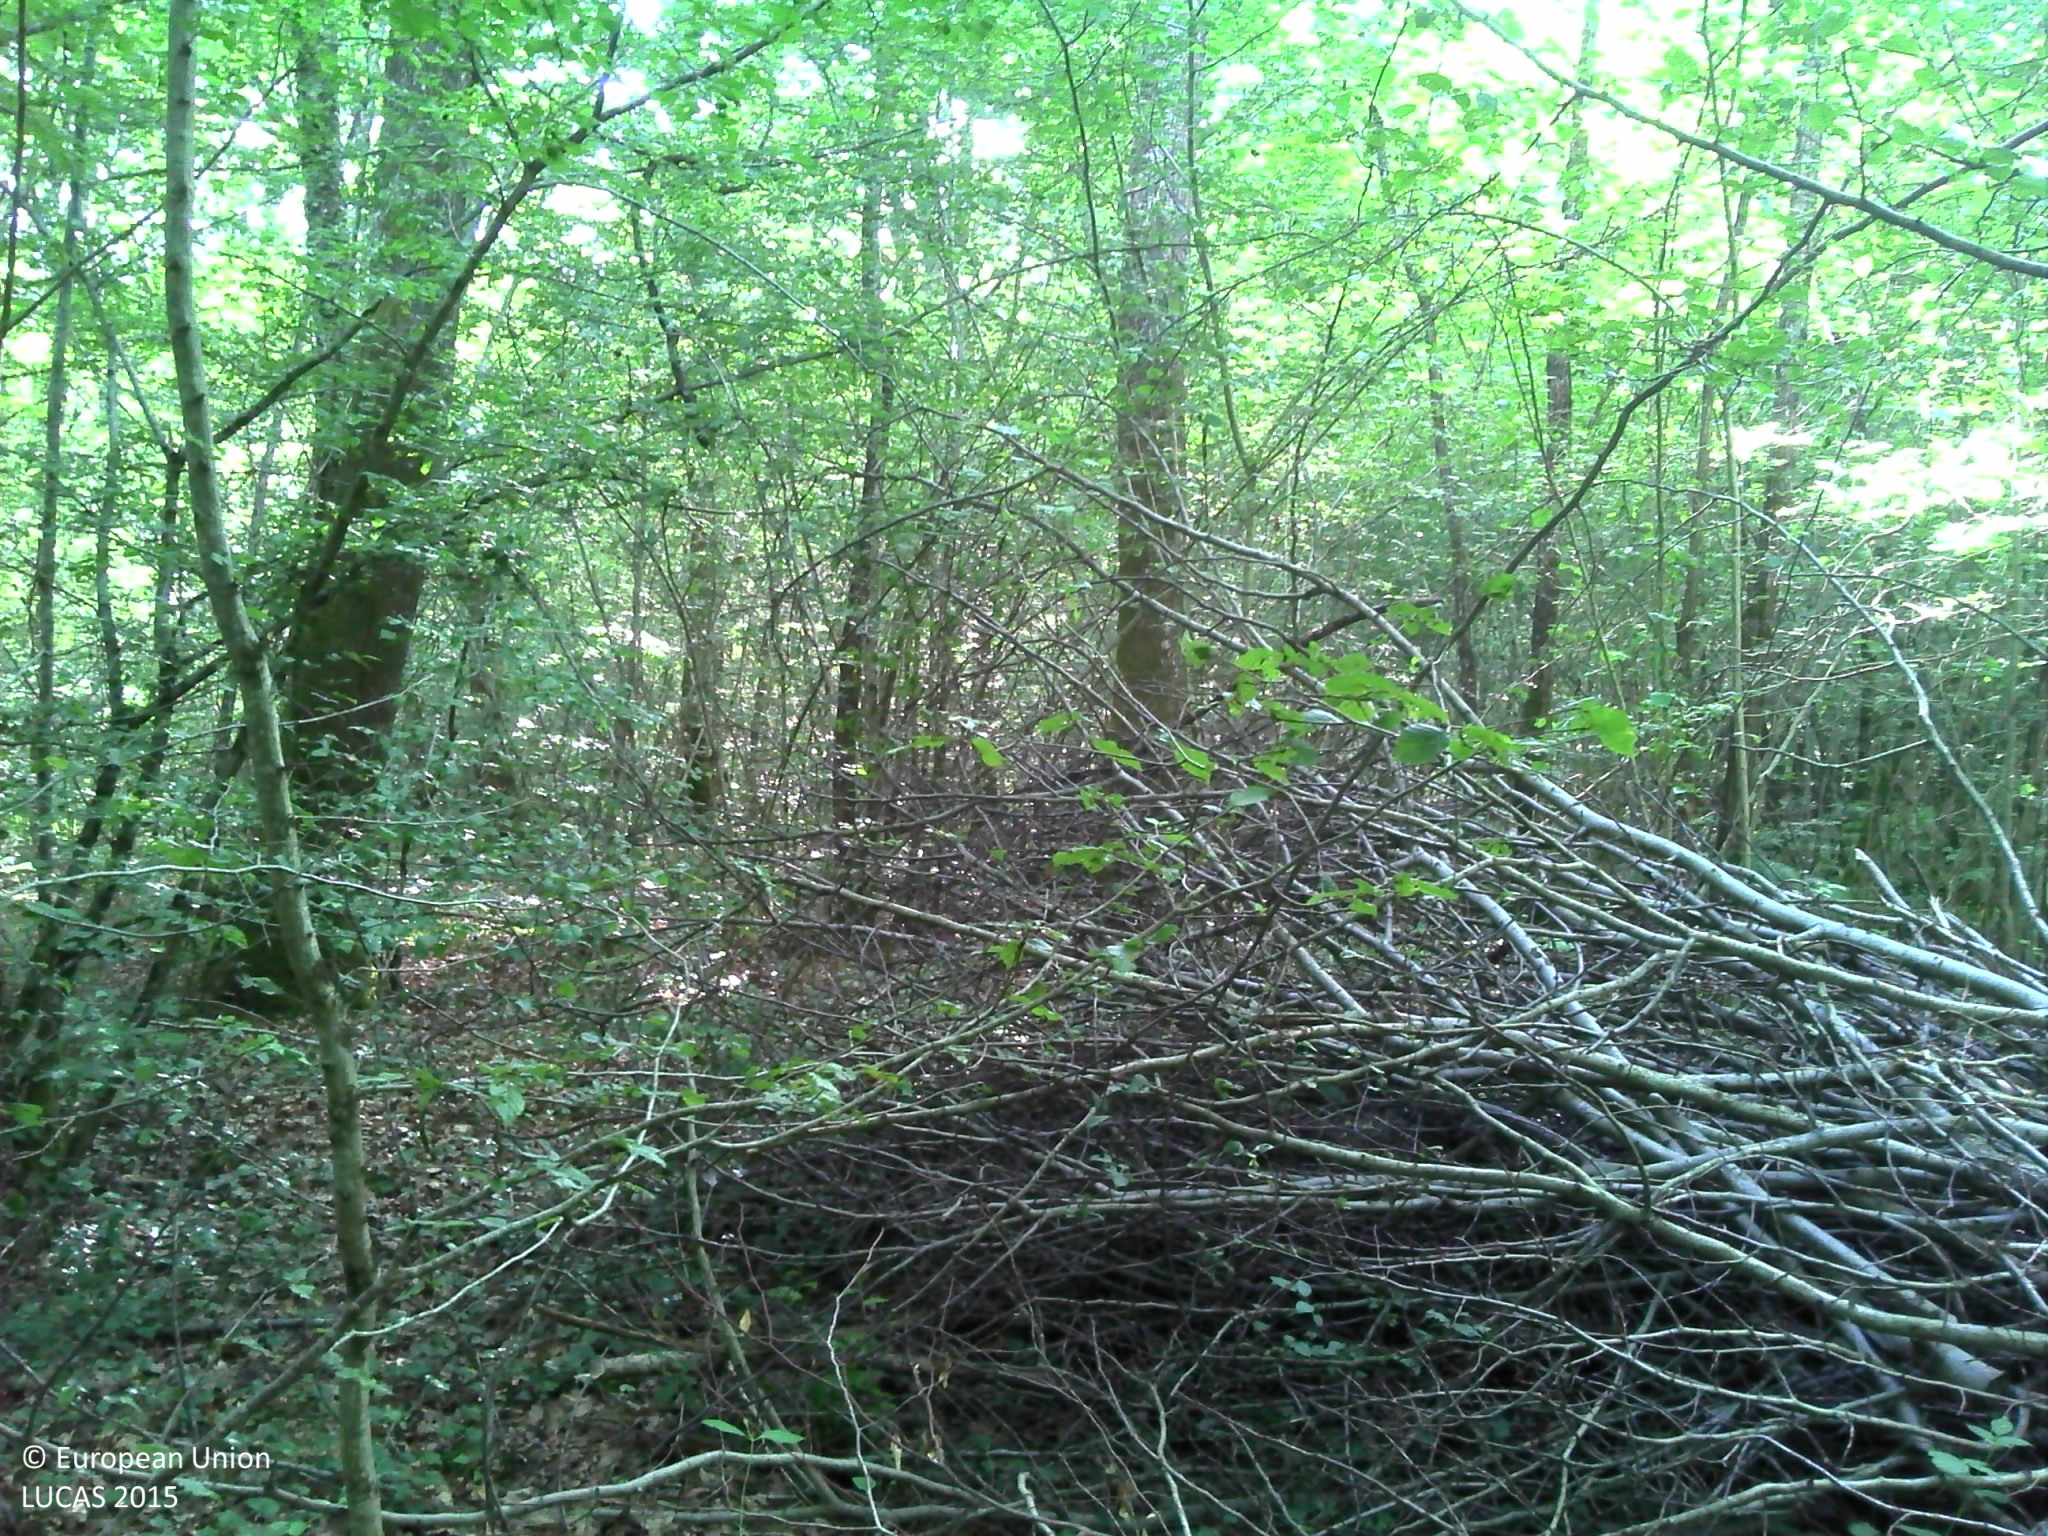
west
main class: Woodland
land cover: Broadleaved woodland
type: mesophytic deciduous forest
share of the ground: > 75 %
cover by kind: broadleaved forest trees 95 %, herbaceous plants 5 %
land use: Forestry
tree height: > 5 m
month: June
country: FR
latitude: 46.9406
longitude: 5.4696
